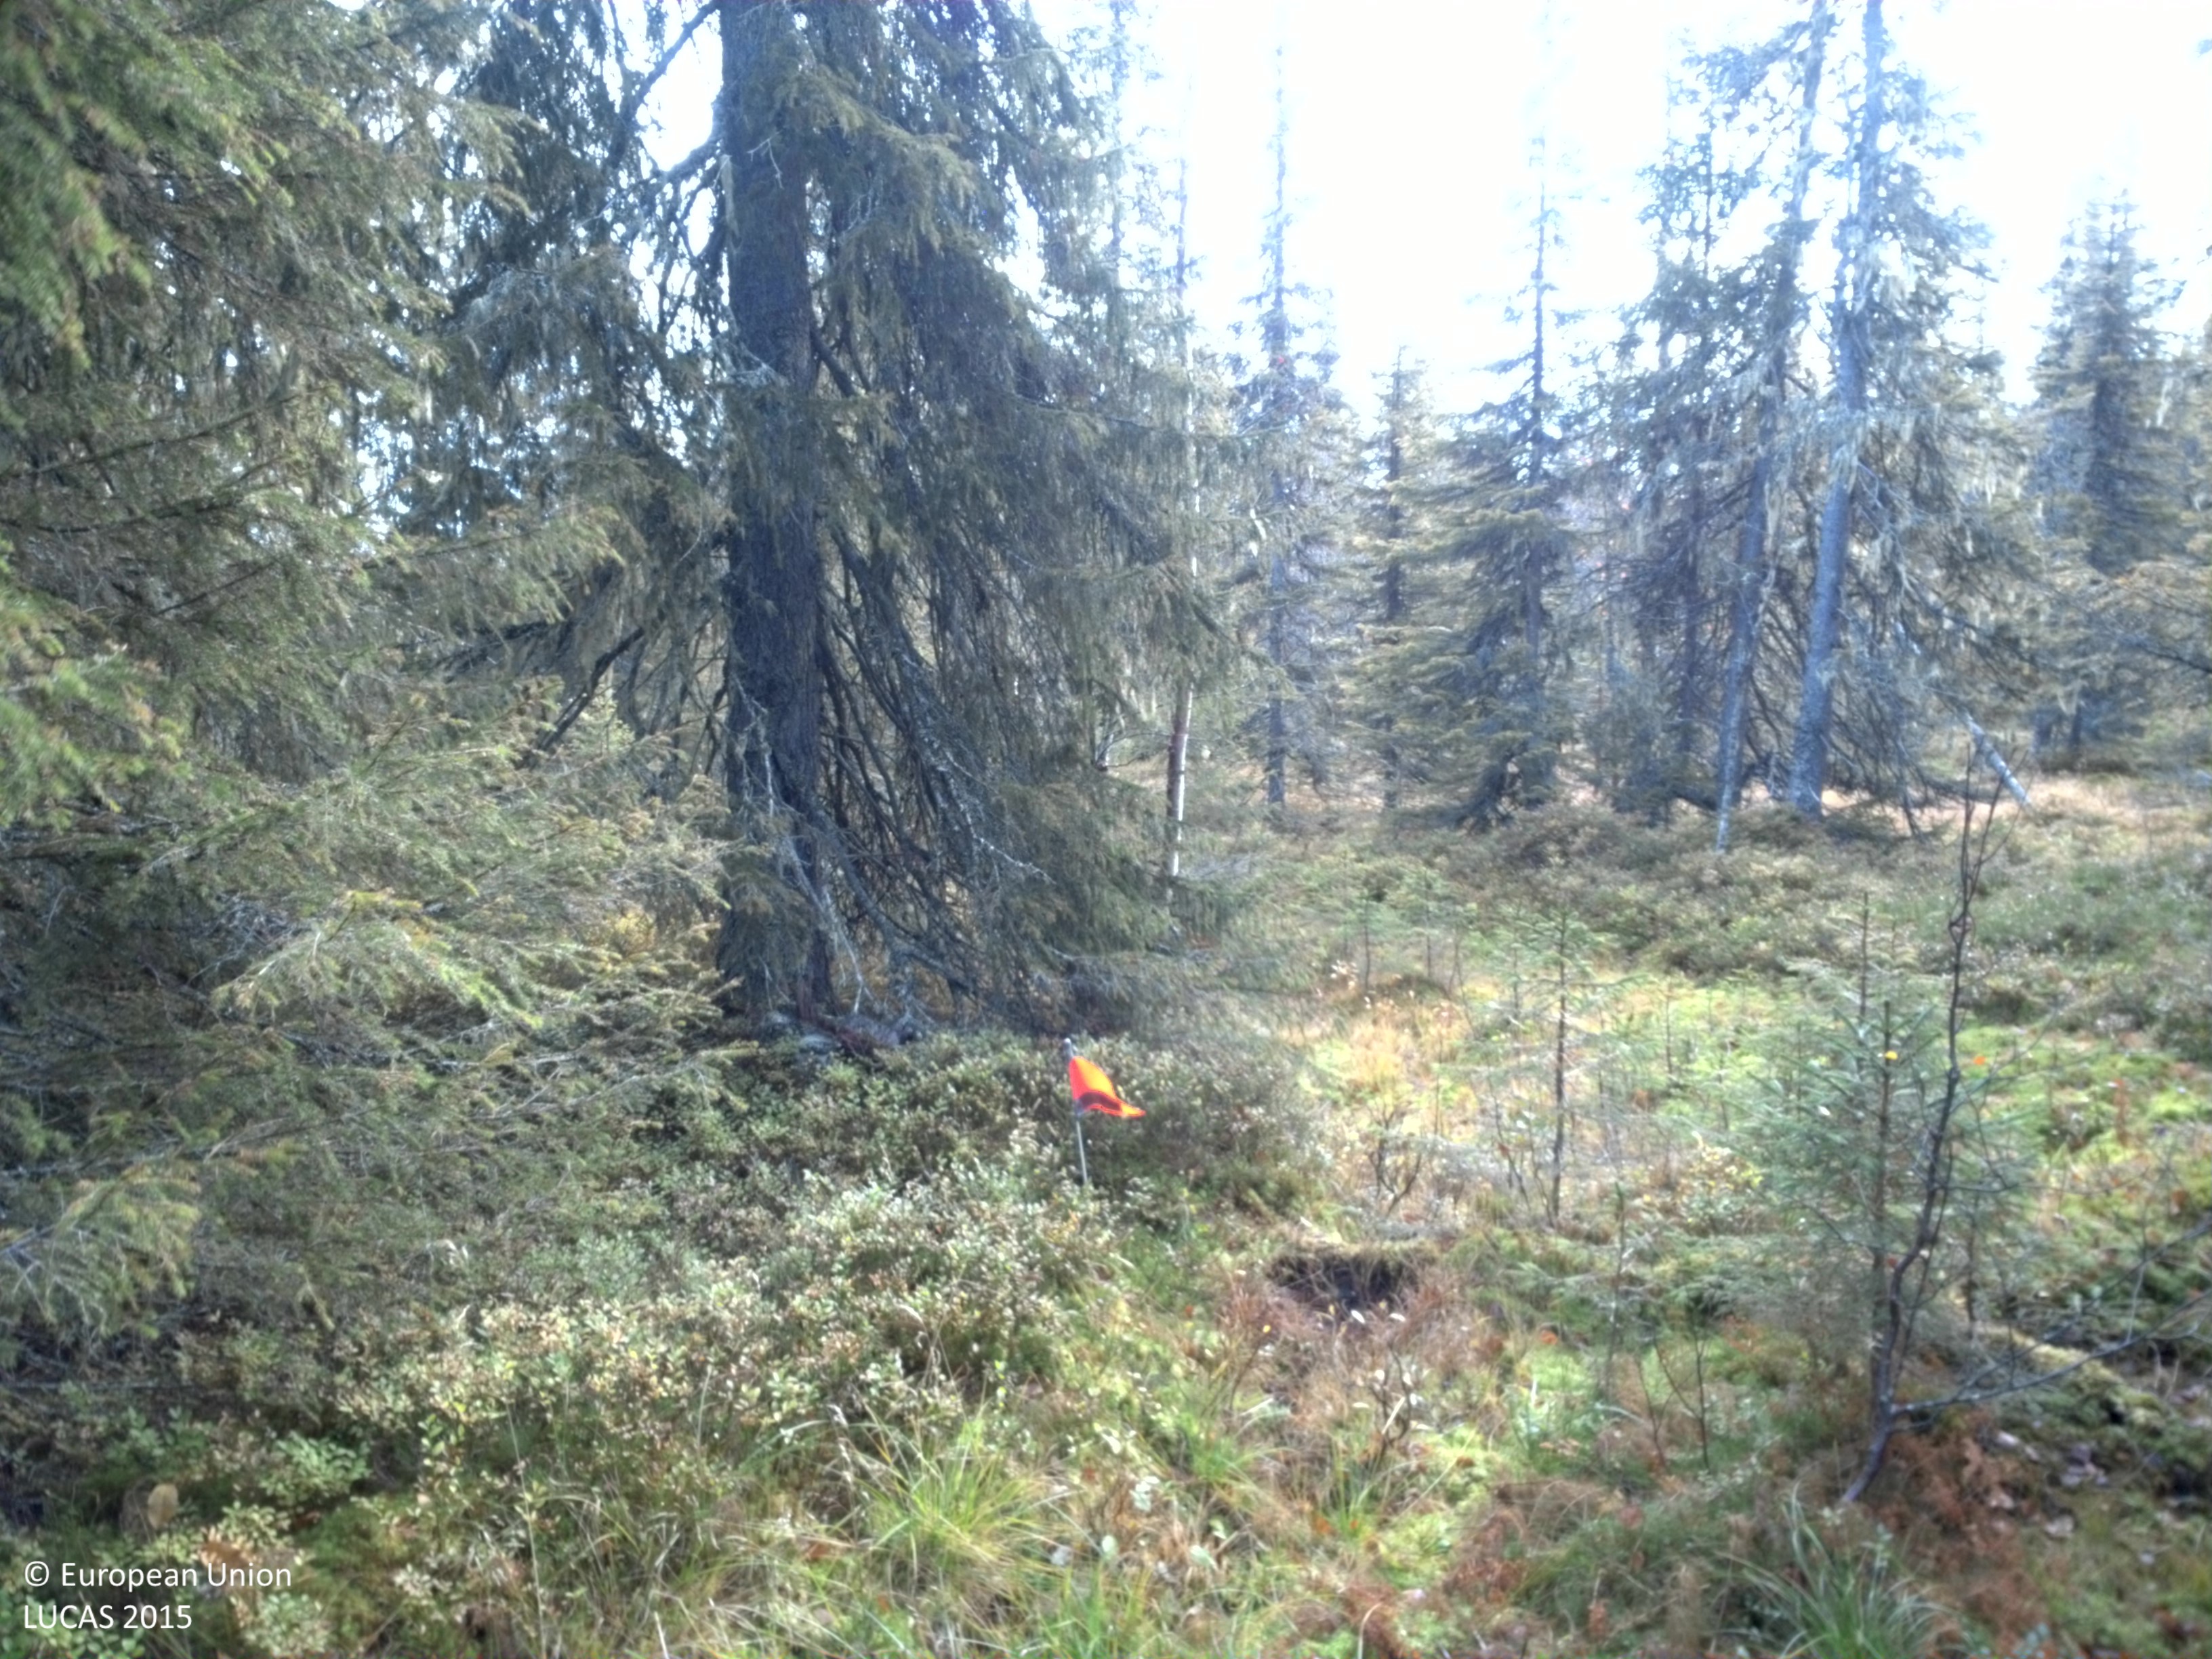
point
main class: Woodland
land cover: Spruce dominated coniferous woodland
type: boreal forest
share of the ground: 25 - 50 %
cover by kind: shrubs 40 %, coniferous forest trees 30 %, lichens and mosses 15 %, herbaceous plants 10 %, broadleaved forest trees 5 %
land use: Forestry
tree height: > 5 m
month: October
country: SE
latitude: 64.7270
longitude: 17.5439
